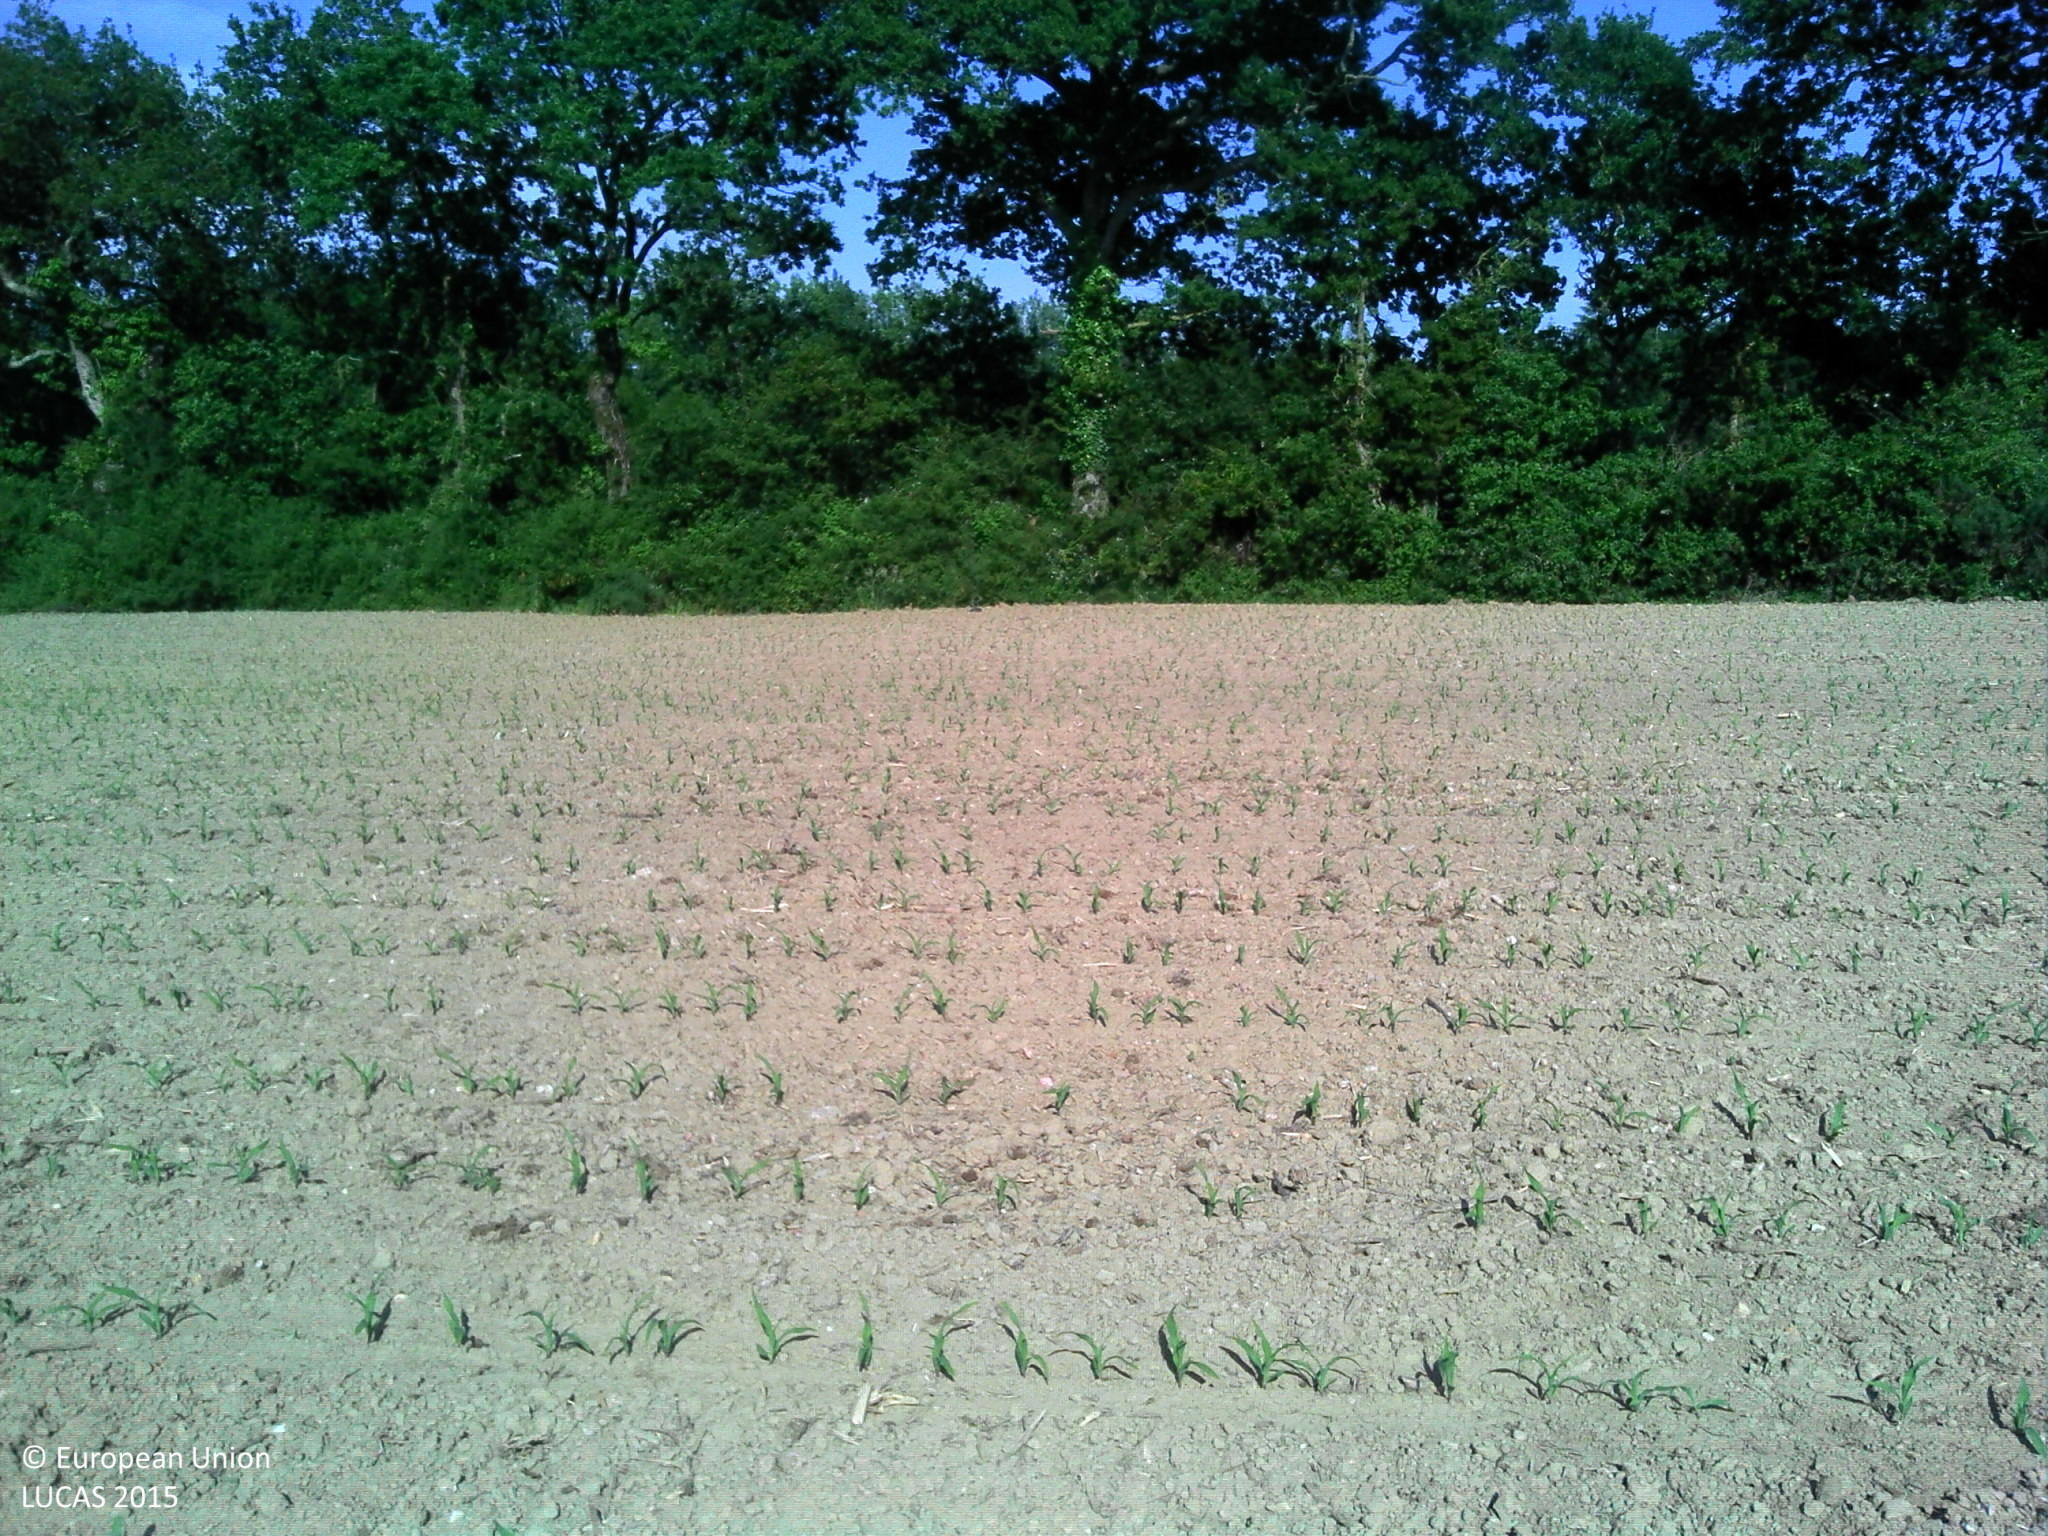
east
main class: Cropland
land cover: Maize
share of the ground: < 10 %
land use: Agriculture (excluding fallow land and kitchen gardens)
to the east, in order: Maize; Managed hedges; Ditches and canals; Grass margins; Tracks; Grass margins; Ditches and canals; Managed hedges; Grassland without tree/shrub cover; Fences; Managed hedges; Grassland without tree/shrub cover; Lines of trees; Rivers and streams; Broadleaved woodland; Tracks; Broadleaved woodland; Tracks; Shrubland without tree cover; Broadleaved woodland
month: June
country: FR
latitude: 46.8645
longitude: -1.7574
